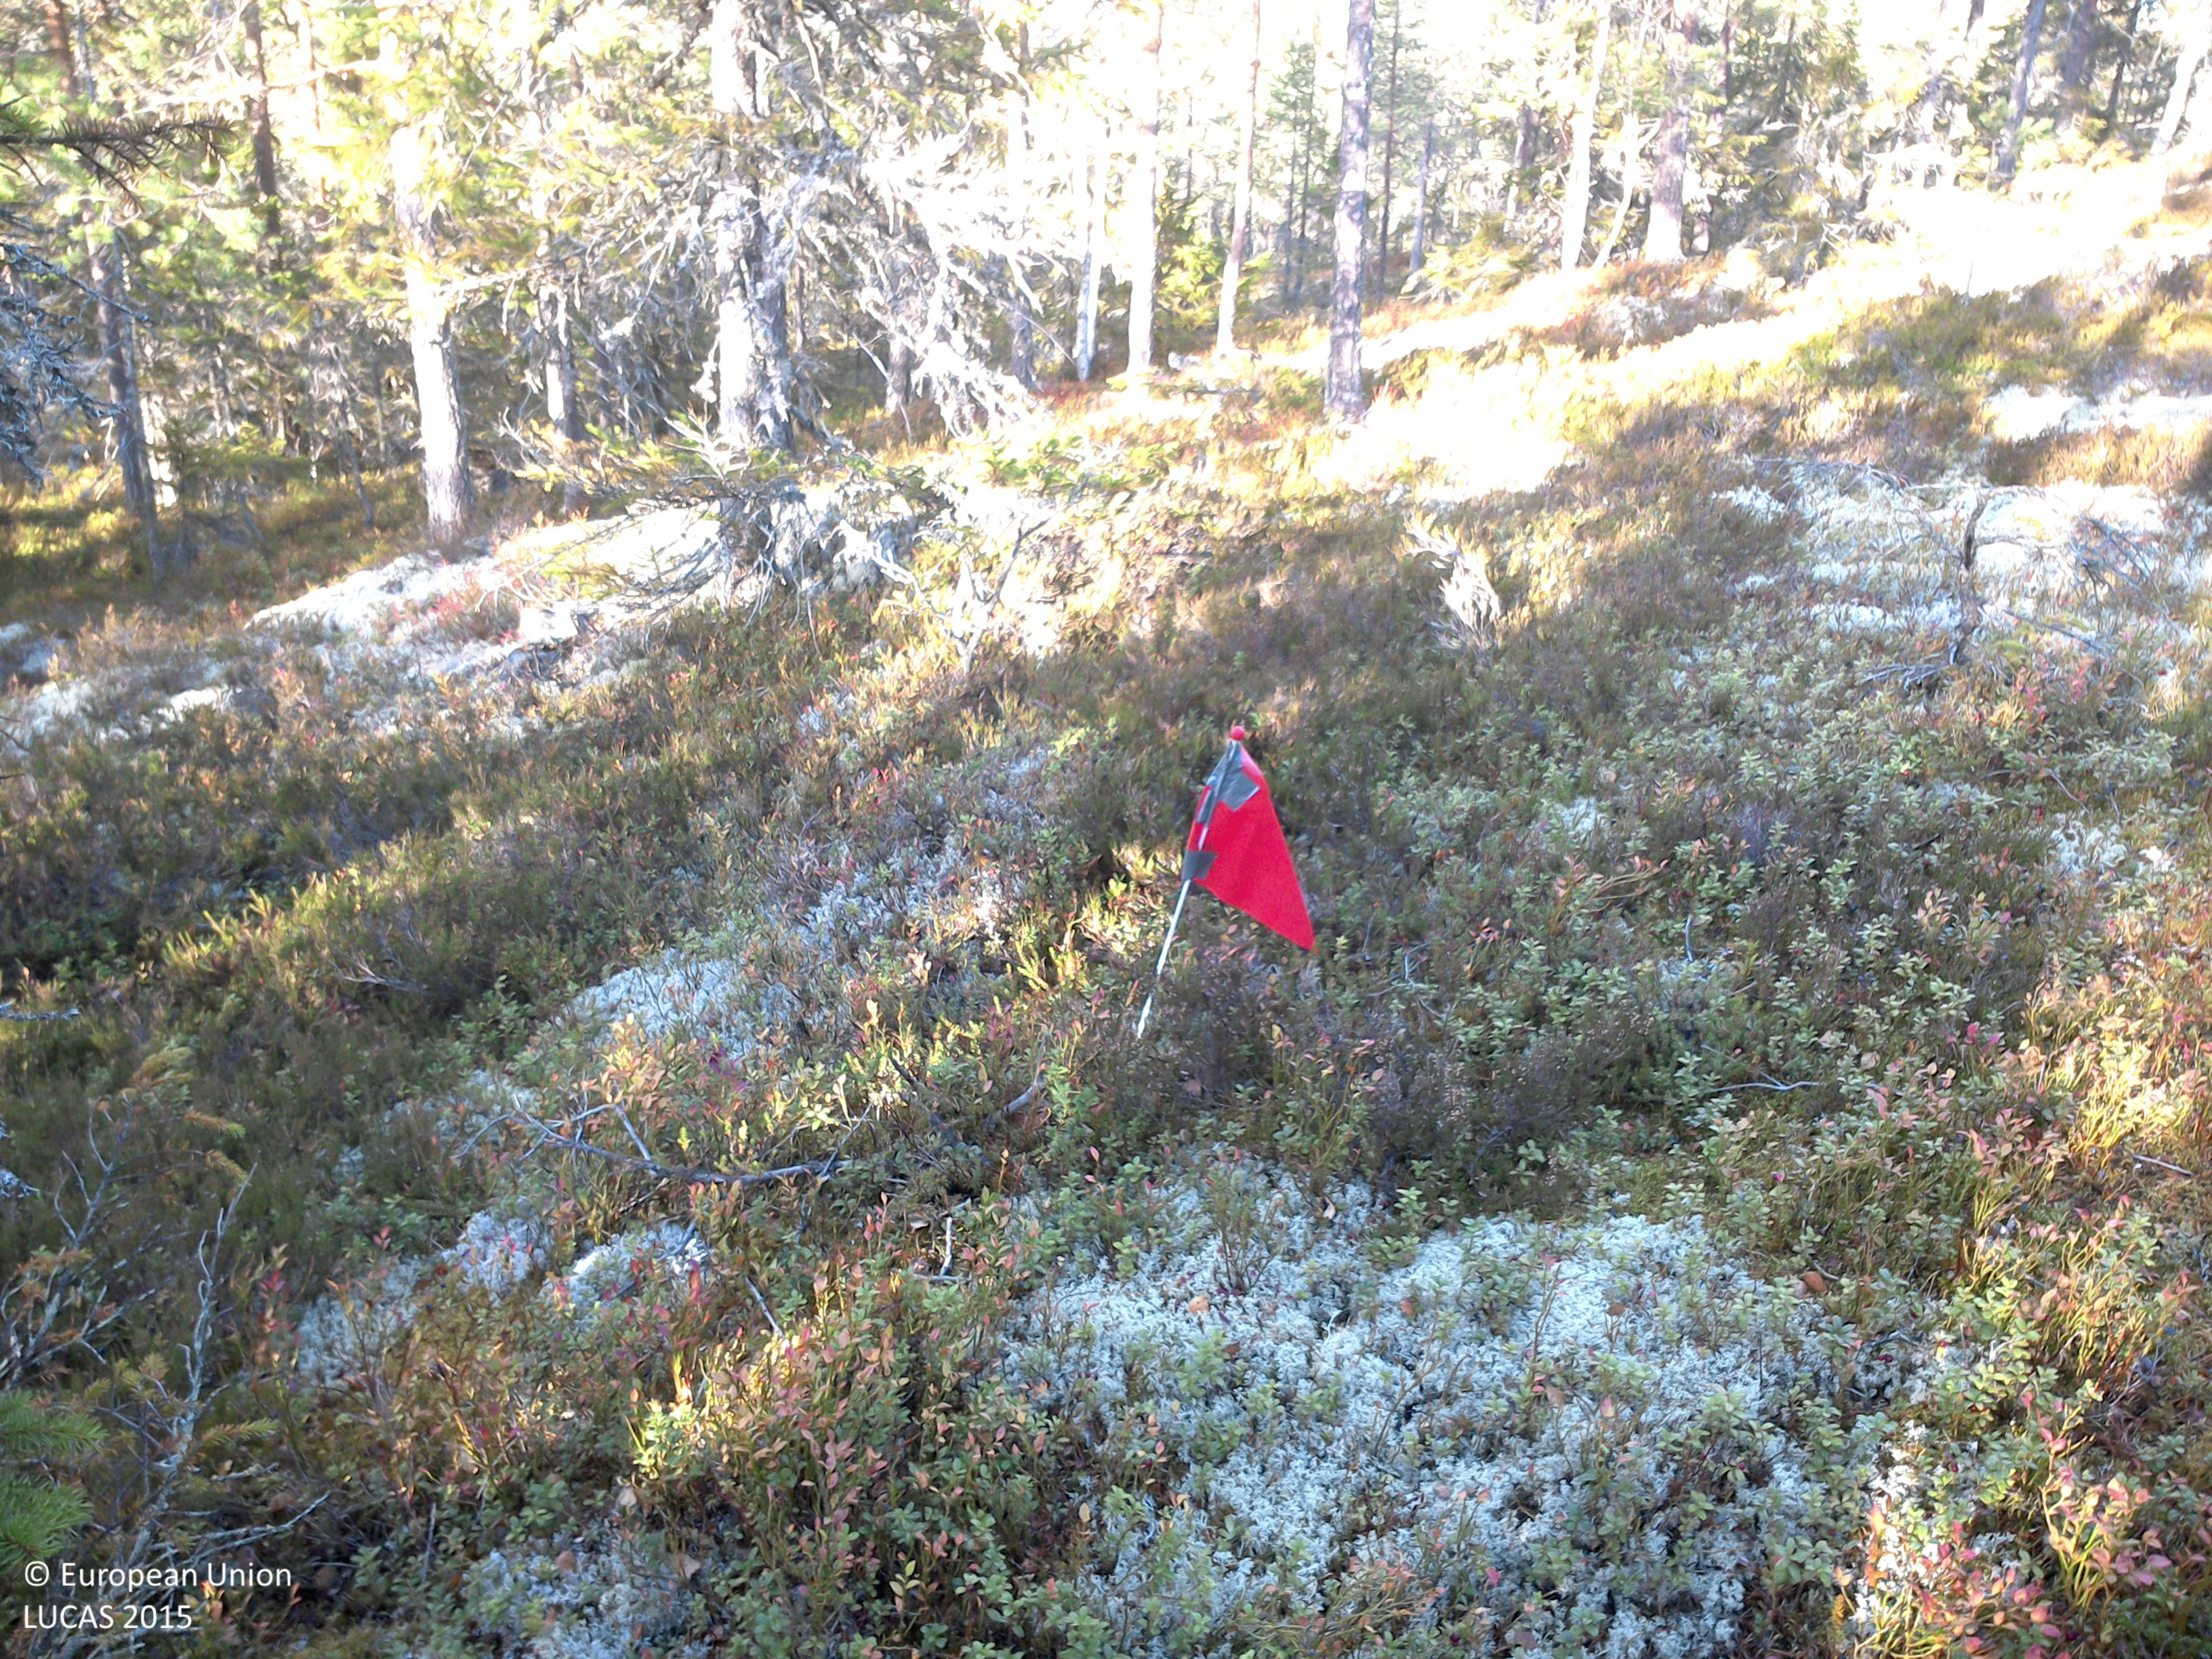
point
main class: Woodland
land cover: Other coniferous woodland
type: boreal forest
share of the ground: 50 - 75 %
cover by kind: coniferous forest trees 50 %, shrubs 50 %
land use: Forestry
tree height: > 5 m
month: October
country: SE
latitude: 63.8829
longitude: 19.9766
